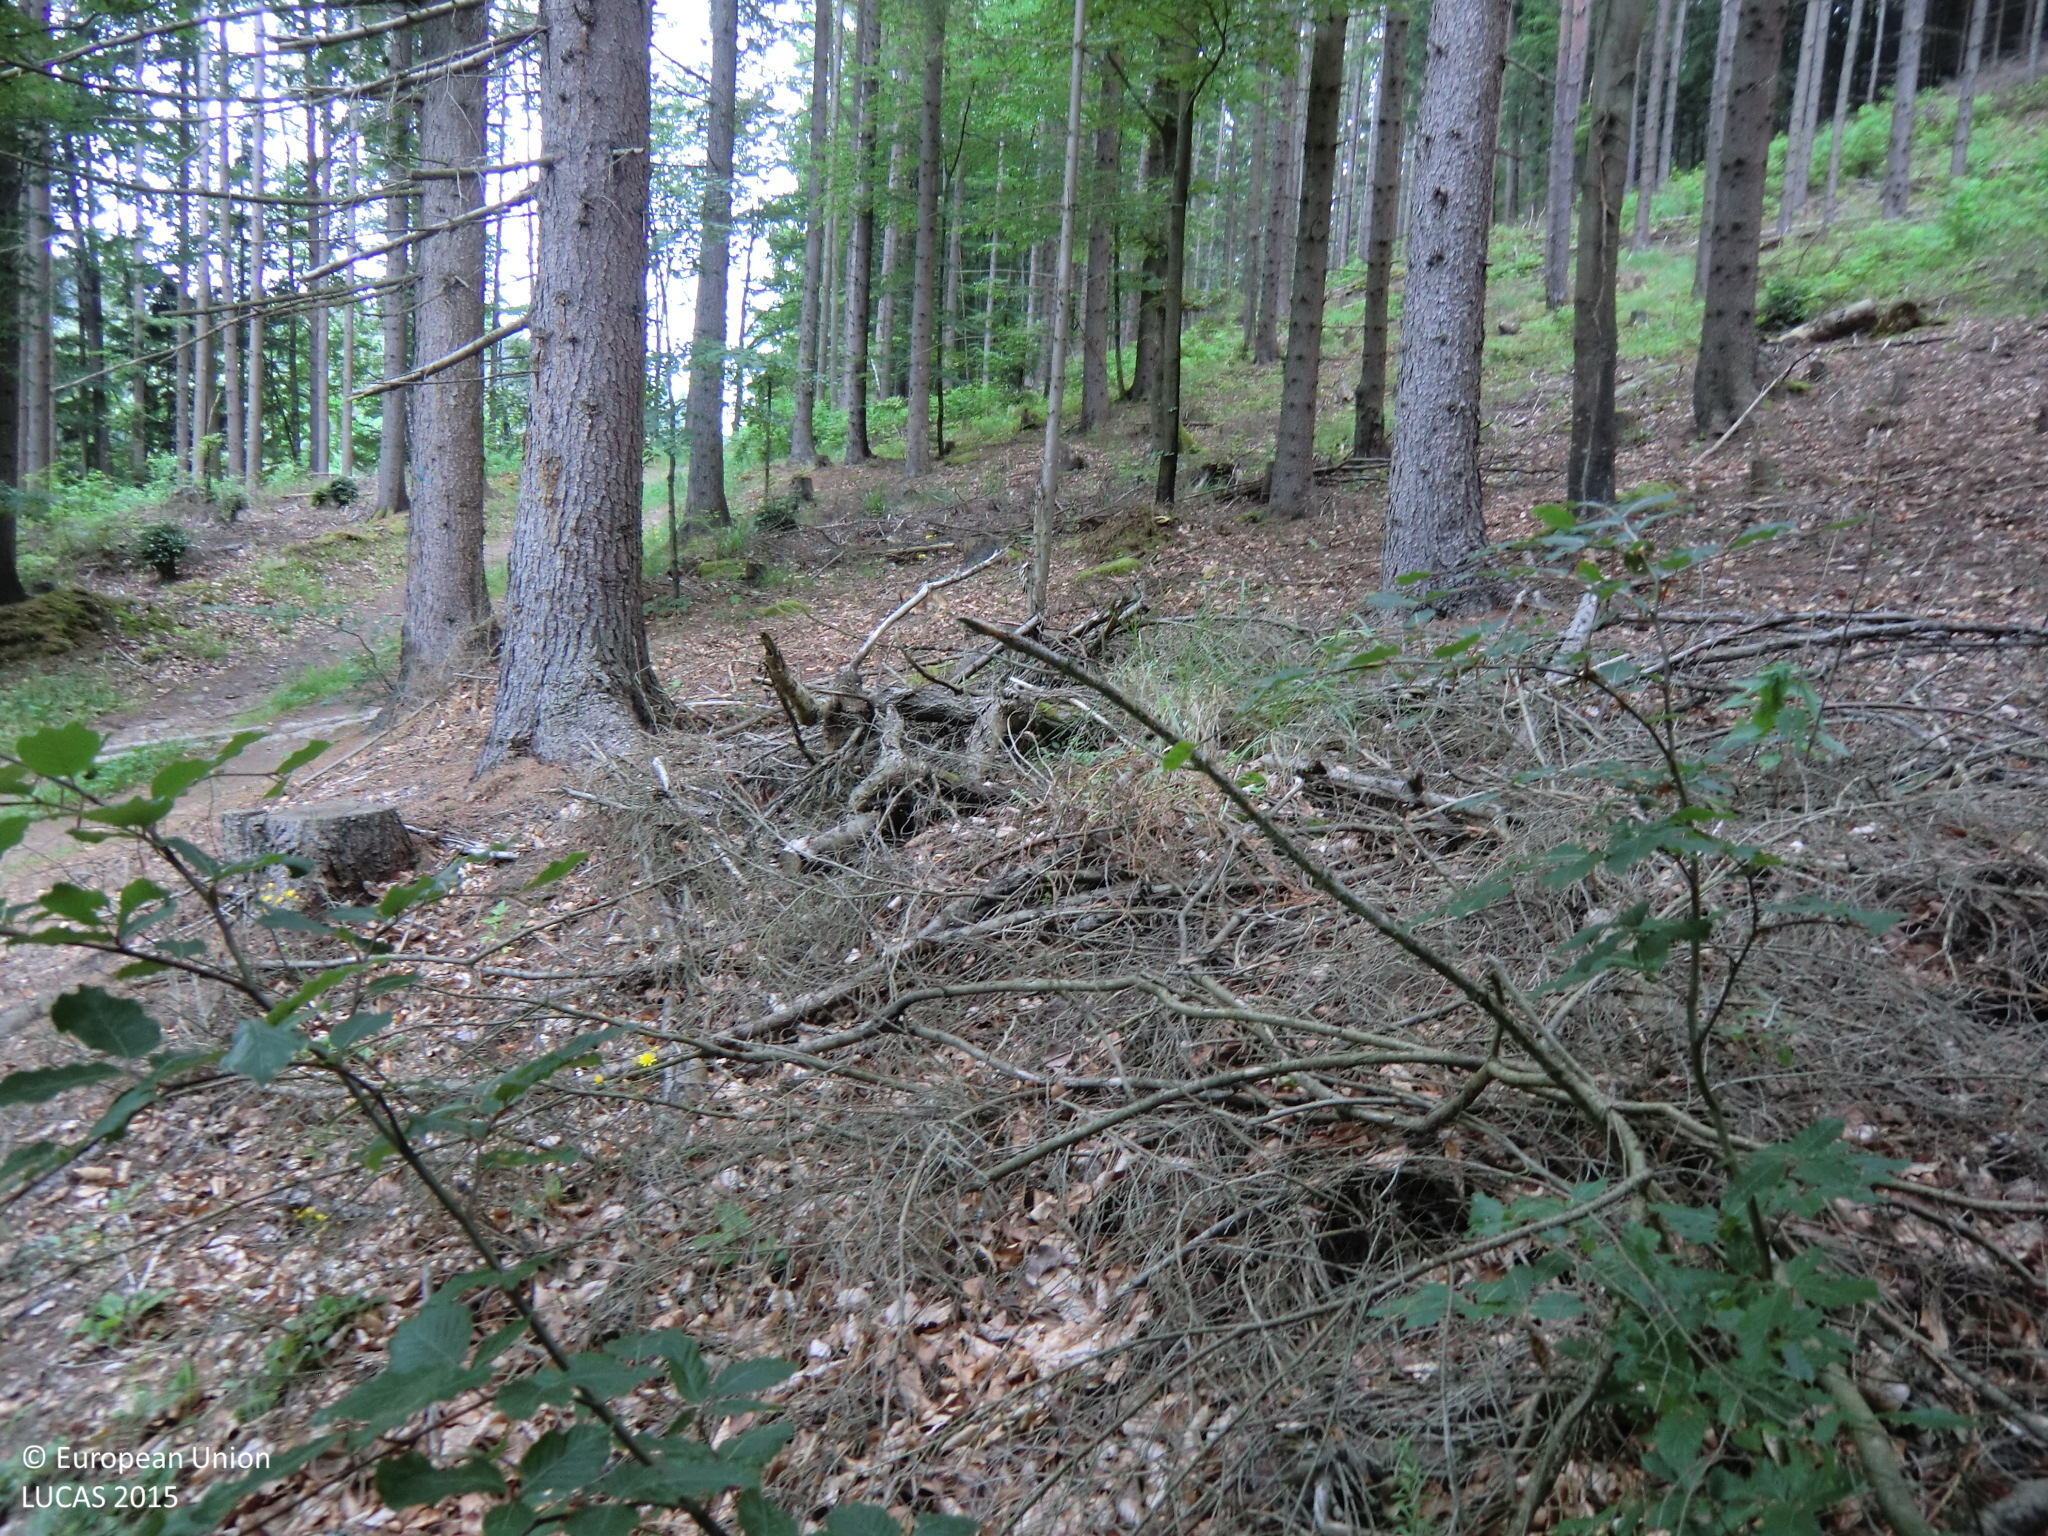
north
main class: Woodland
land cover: Spruce dominated mixed woodland
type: hemiboreal forest and nemoral coniferous forest and mixed broadleaved-coniferous forest
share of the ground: > 75 %
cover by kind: coniferous forest trees 40 %, broadleaved forest trees 40 %, unconsolidated bare surface 15 %, herbaceous plants 5 %
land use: Forestry
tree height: > 5 m
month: June
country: AT
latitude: 48.5966
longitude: 15.0052
